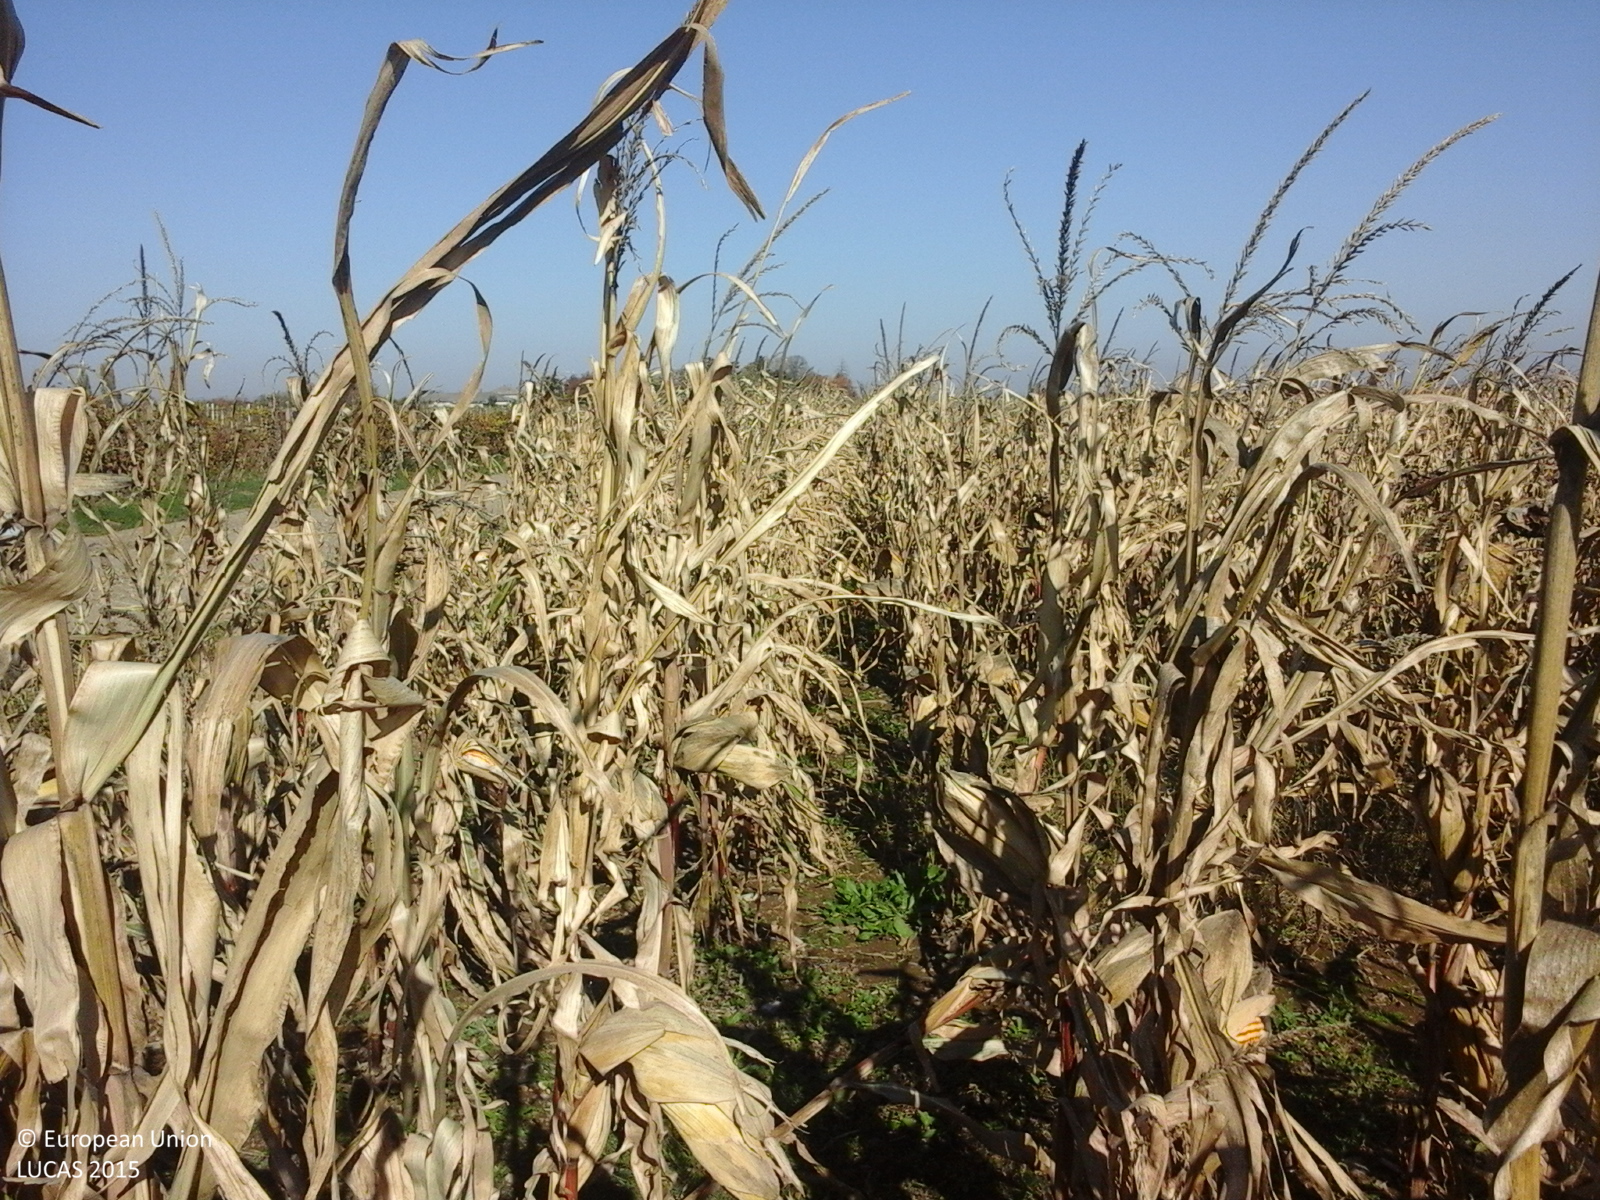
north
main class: Cropland
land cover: Maize
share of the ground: > 75 %
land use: Agriculture (excluding fallow land and kitchen gardens)
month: October
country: RO
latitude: 45.9134
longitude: 27.1257
